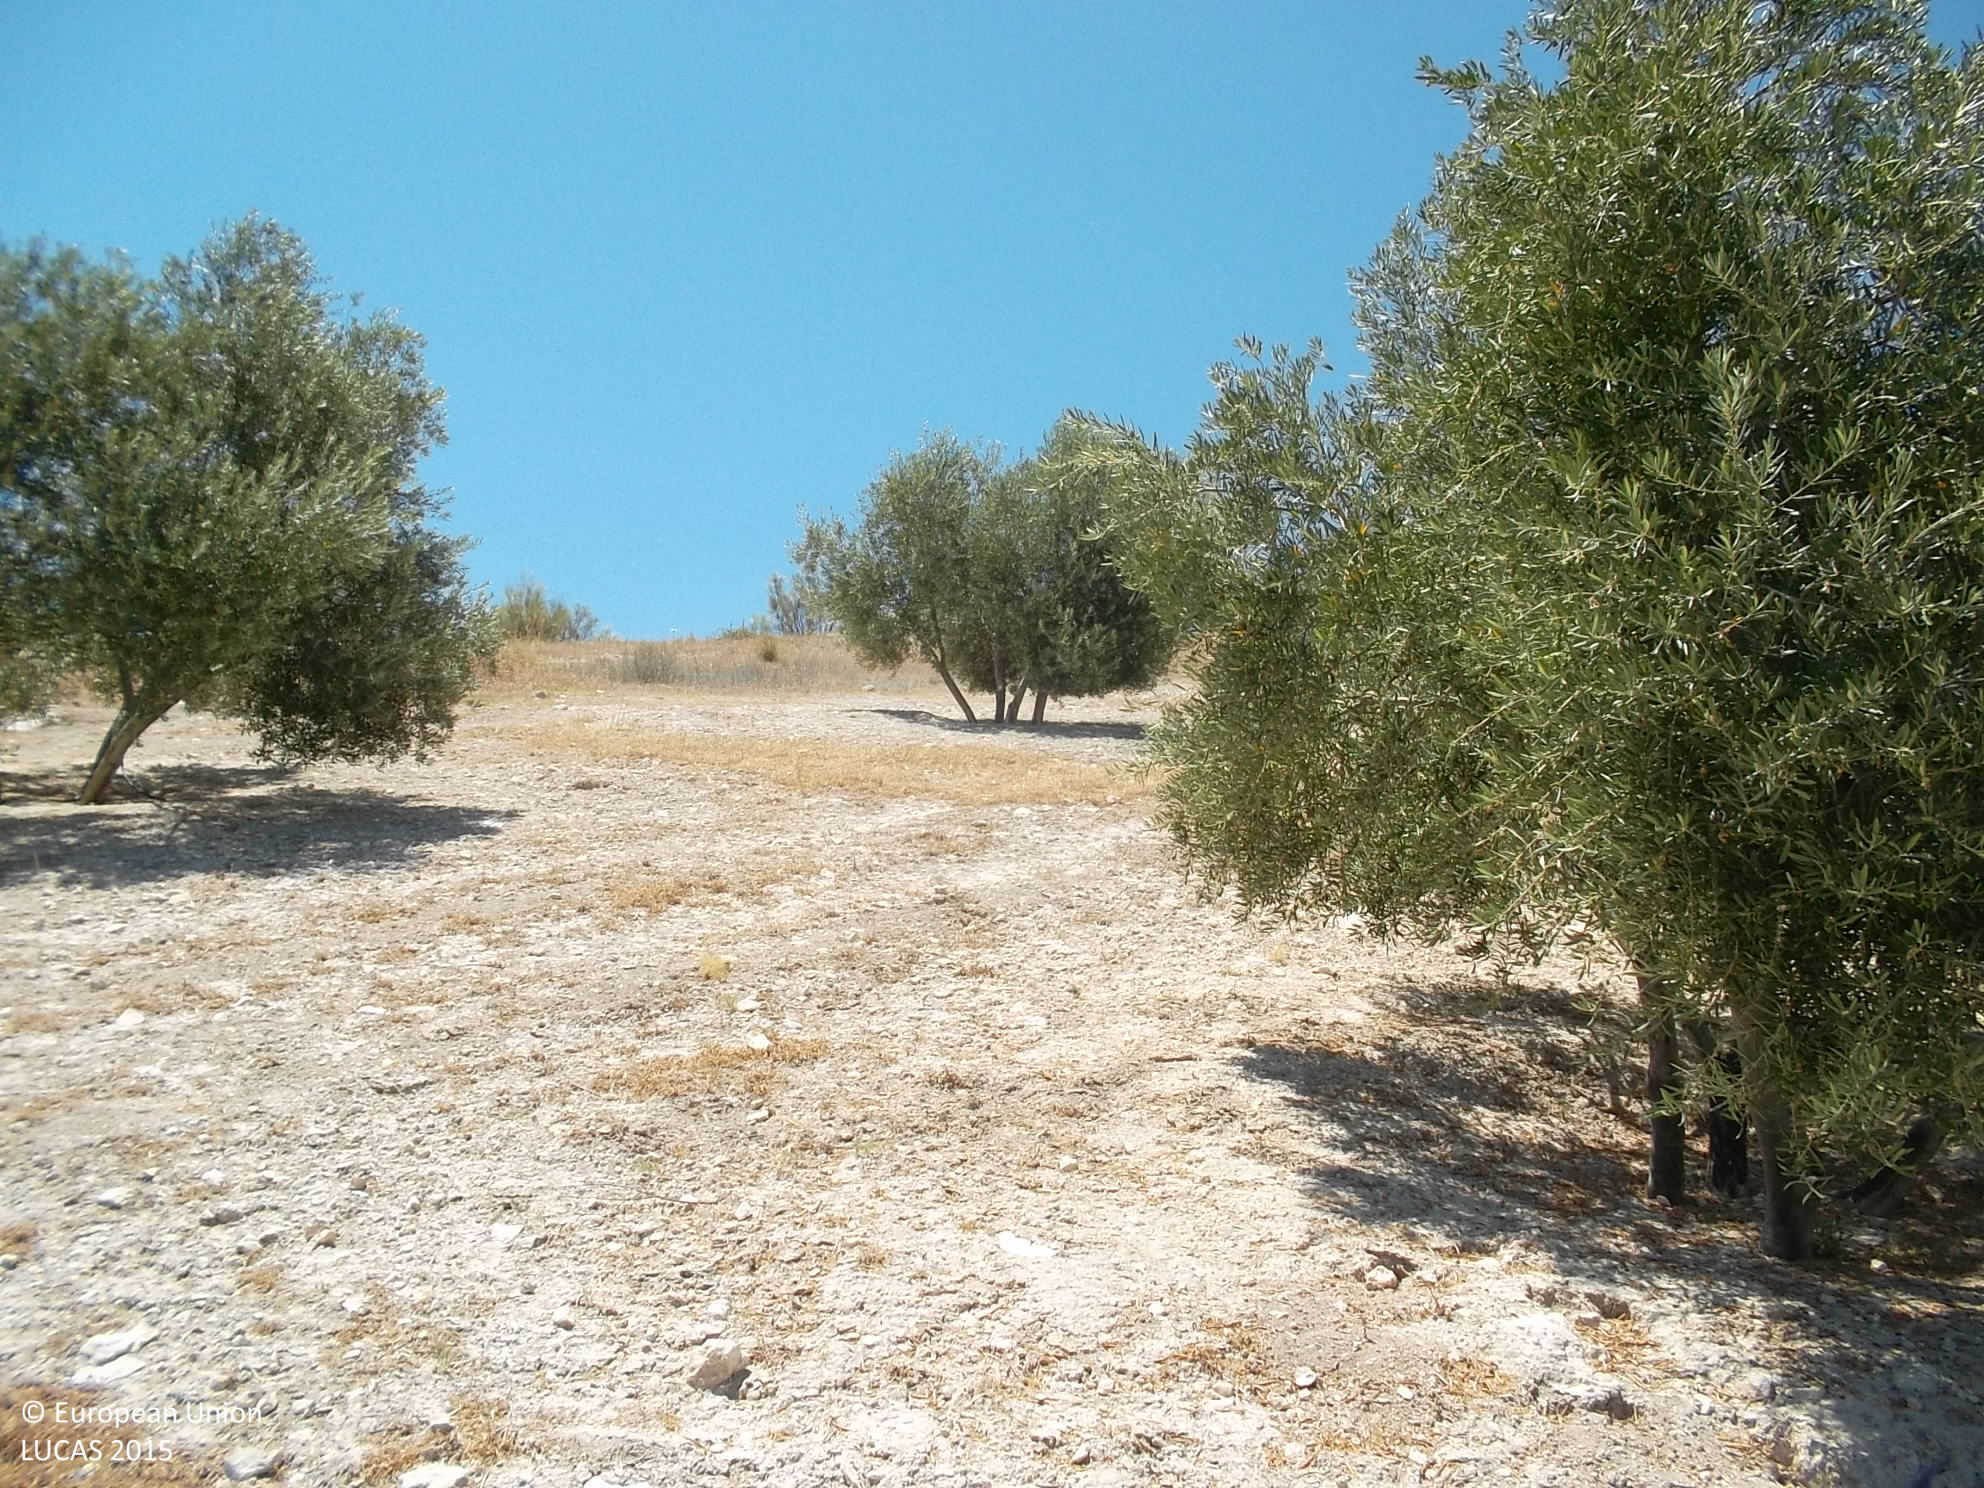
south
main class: Cropland
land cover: Olive groves
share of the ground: 25 - 50 %
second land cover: Other bare soil
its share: > 75 %
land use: Agriculture (excluding fallow land and kitchen gardens)
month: June
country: ES
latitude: 37.8800
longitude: -3.3800
